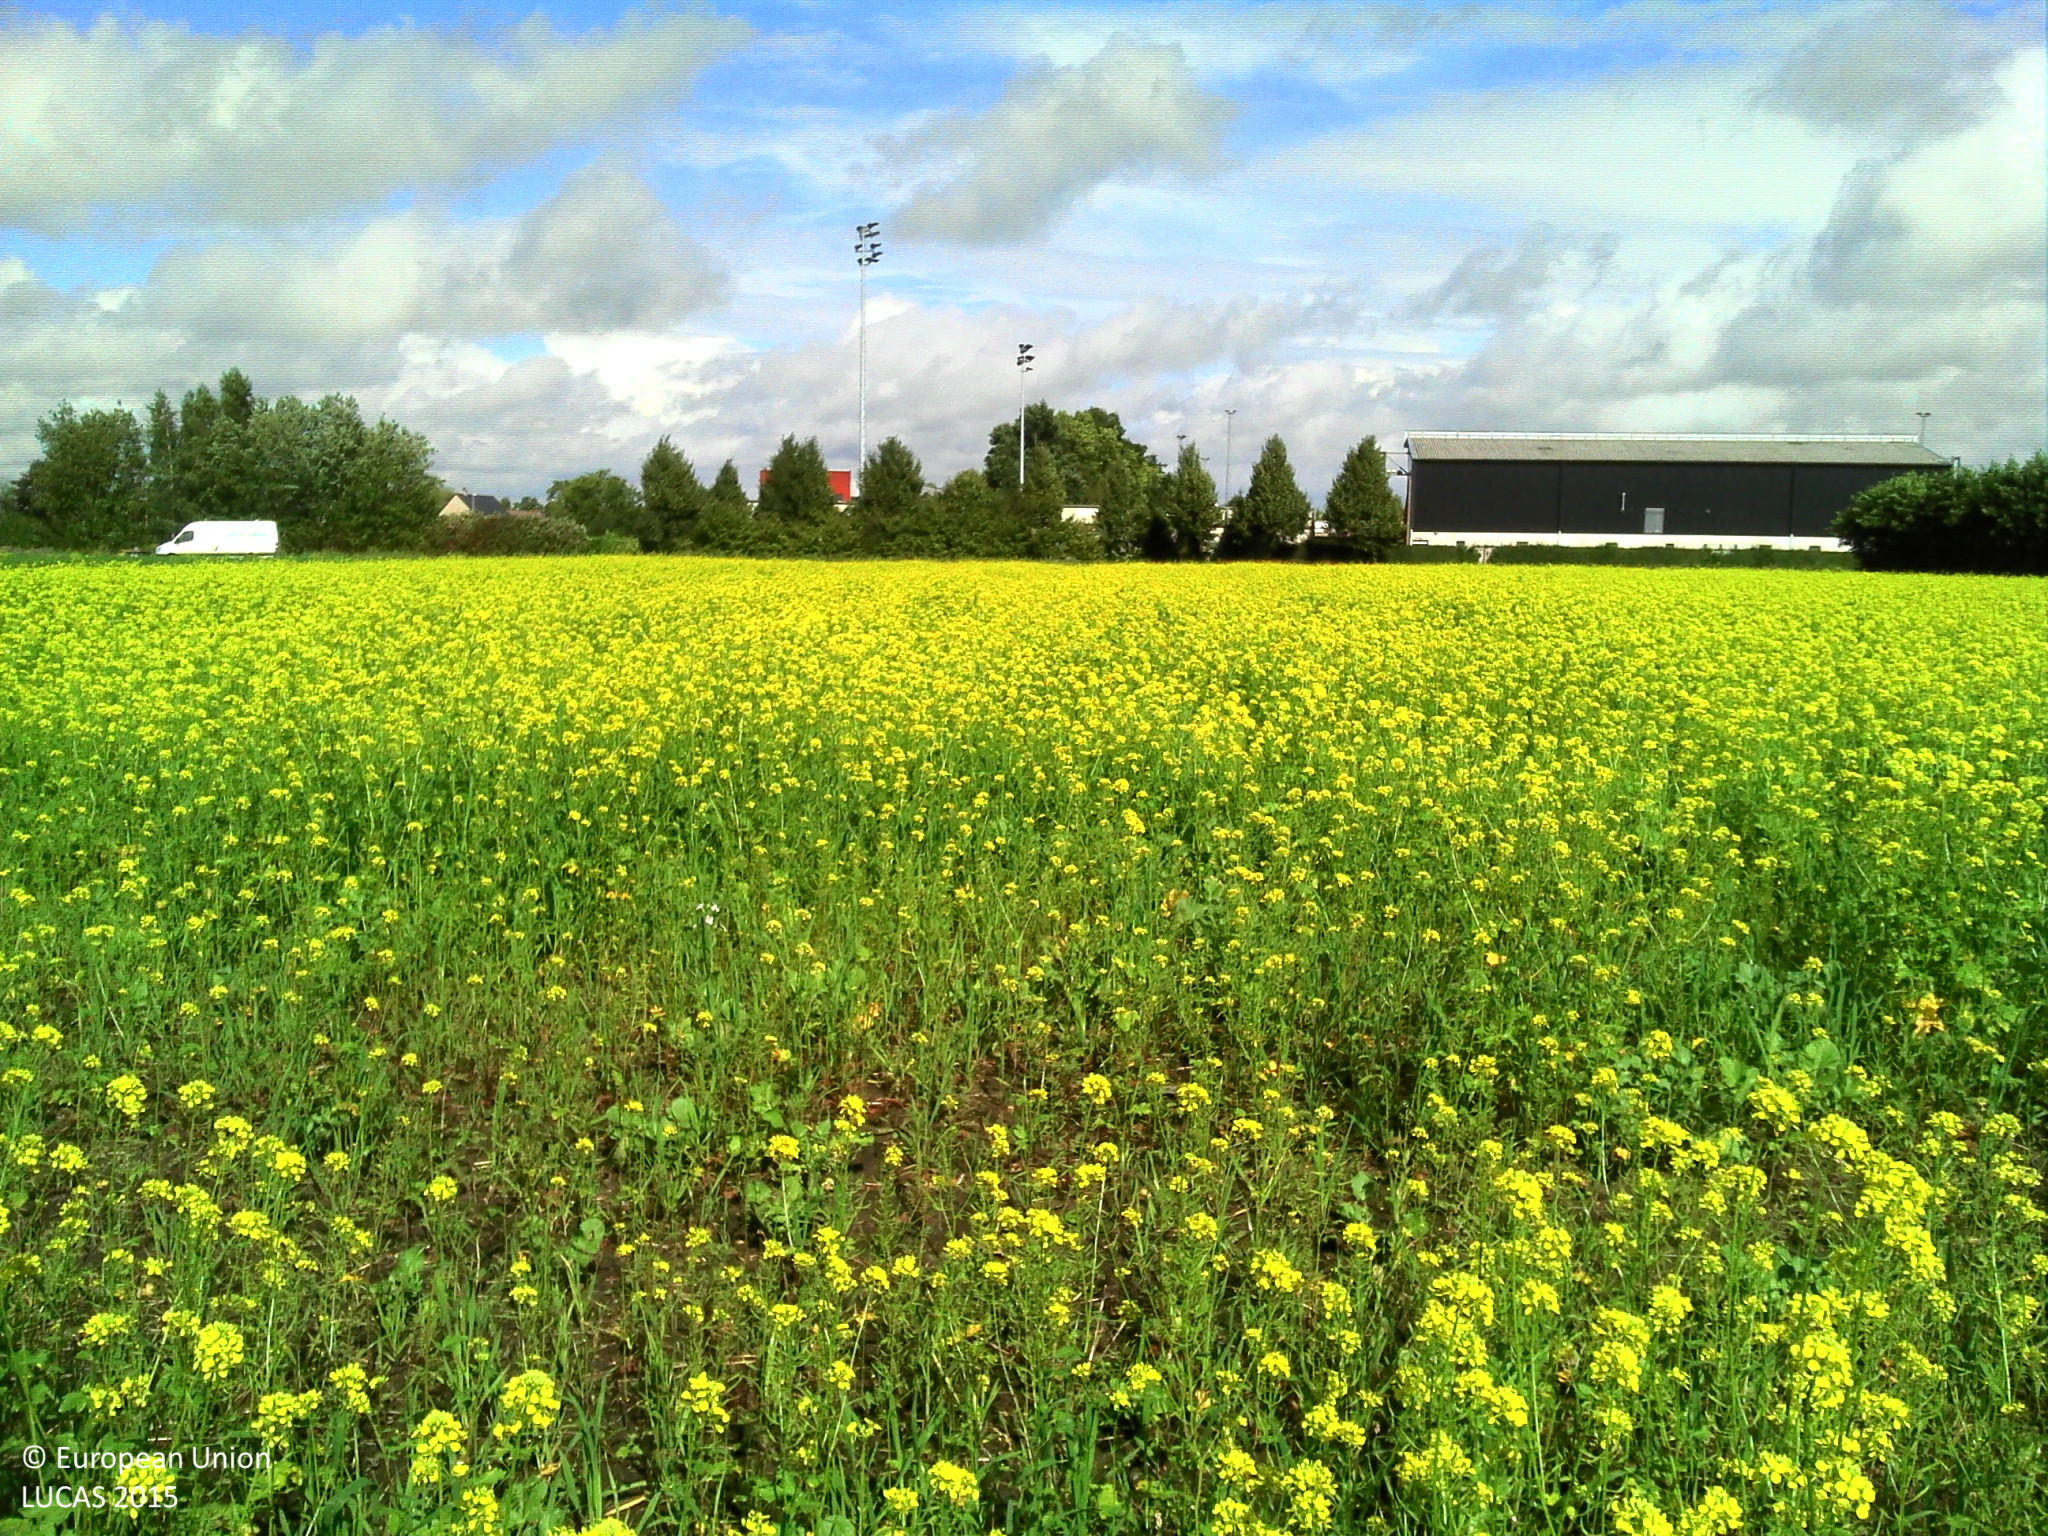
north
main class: Grassland
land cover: Grassland with sparse tree/shrub cover
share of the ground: > 75 %
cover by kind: herbaceous plants 95 %, broadleaved forest trees 5 %
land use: Residential
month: September
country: BE
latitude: 51.3967
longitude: 4.7503
